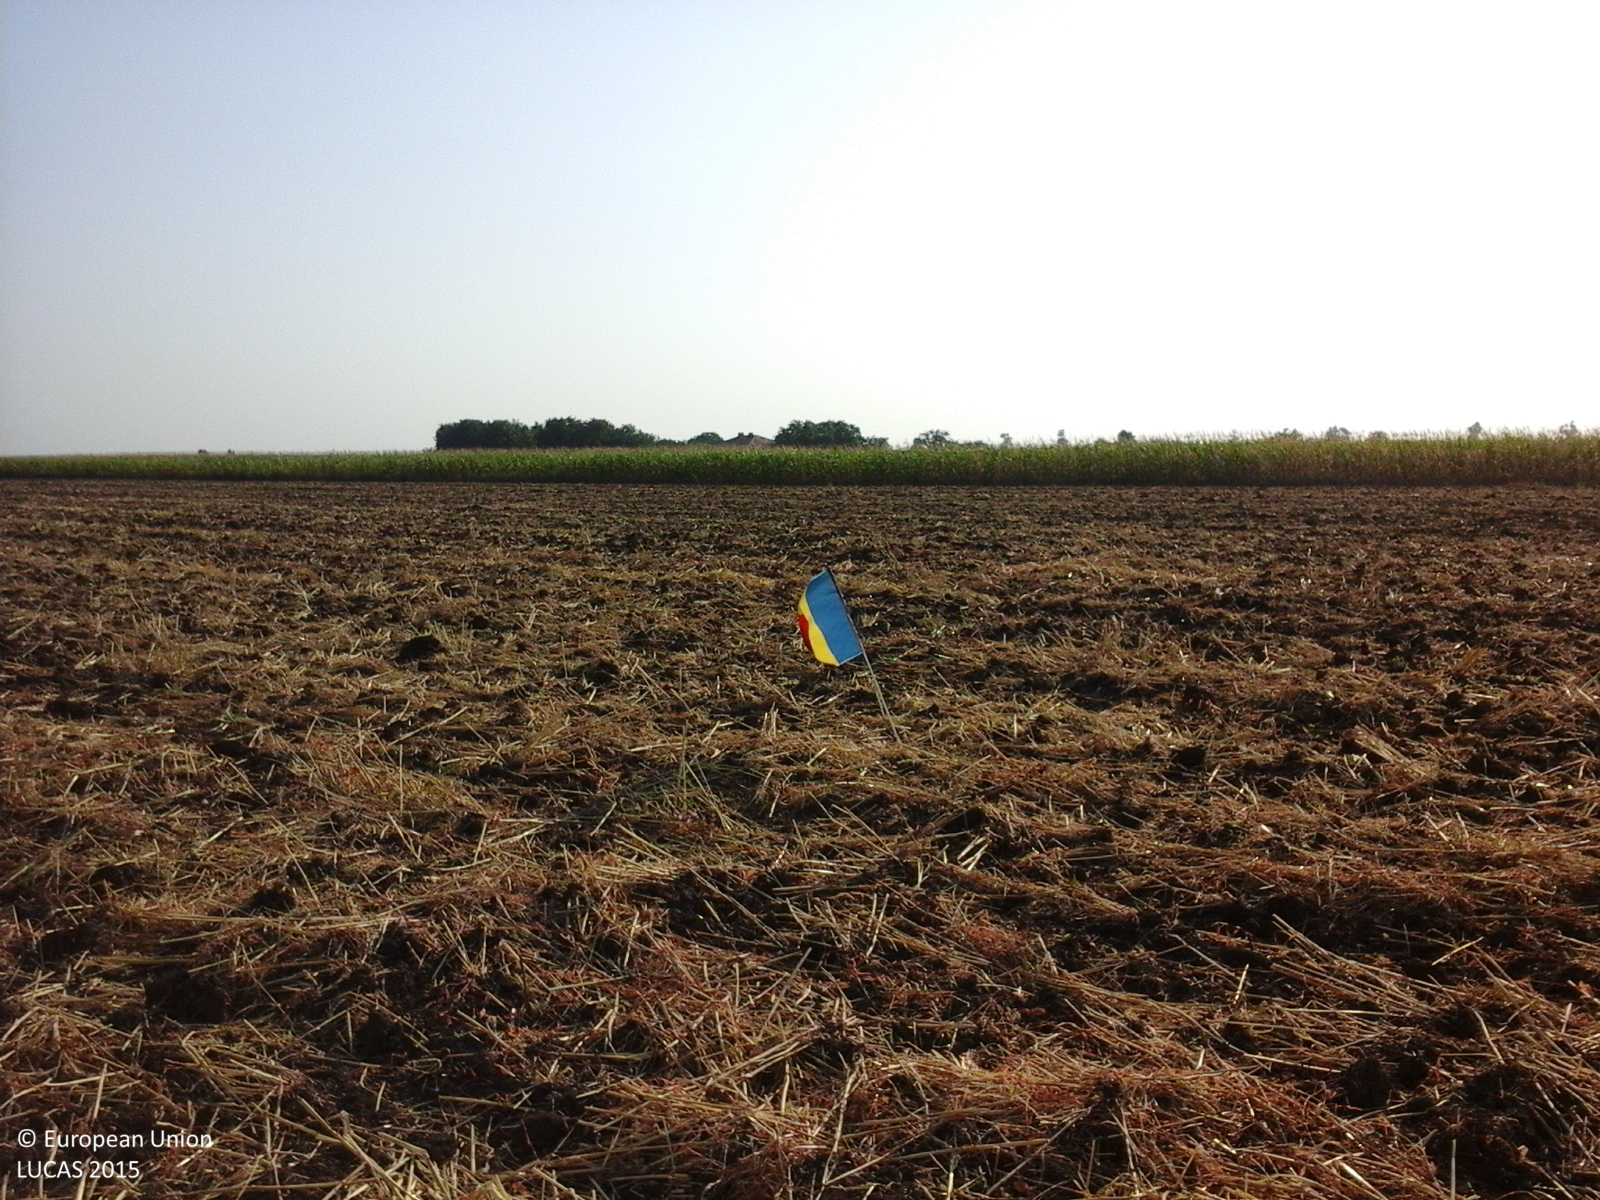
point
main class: Cropland
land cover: Common wheat
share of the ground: 25 - 50 %
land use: Agriculture (excluding fallow land and kitchen gardens)
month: July
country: RO
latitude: 45.6870
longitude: 27.9265
